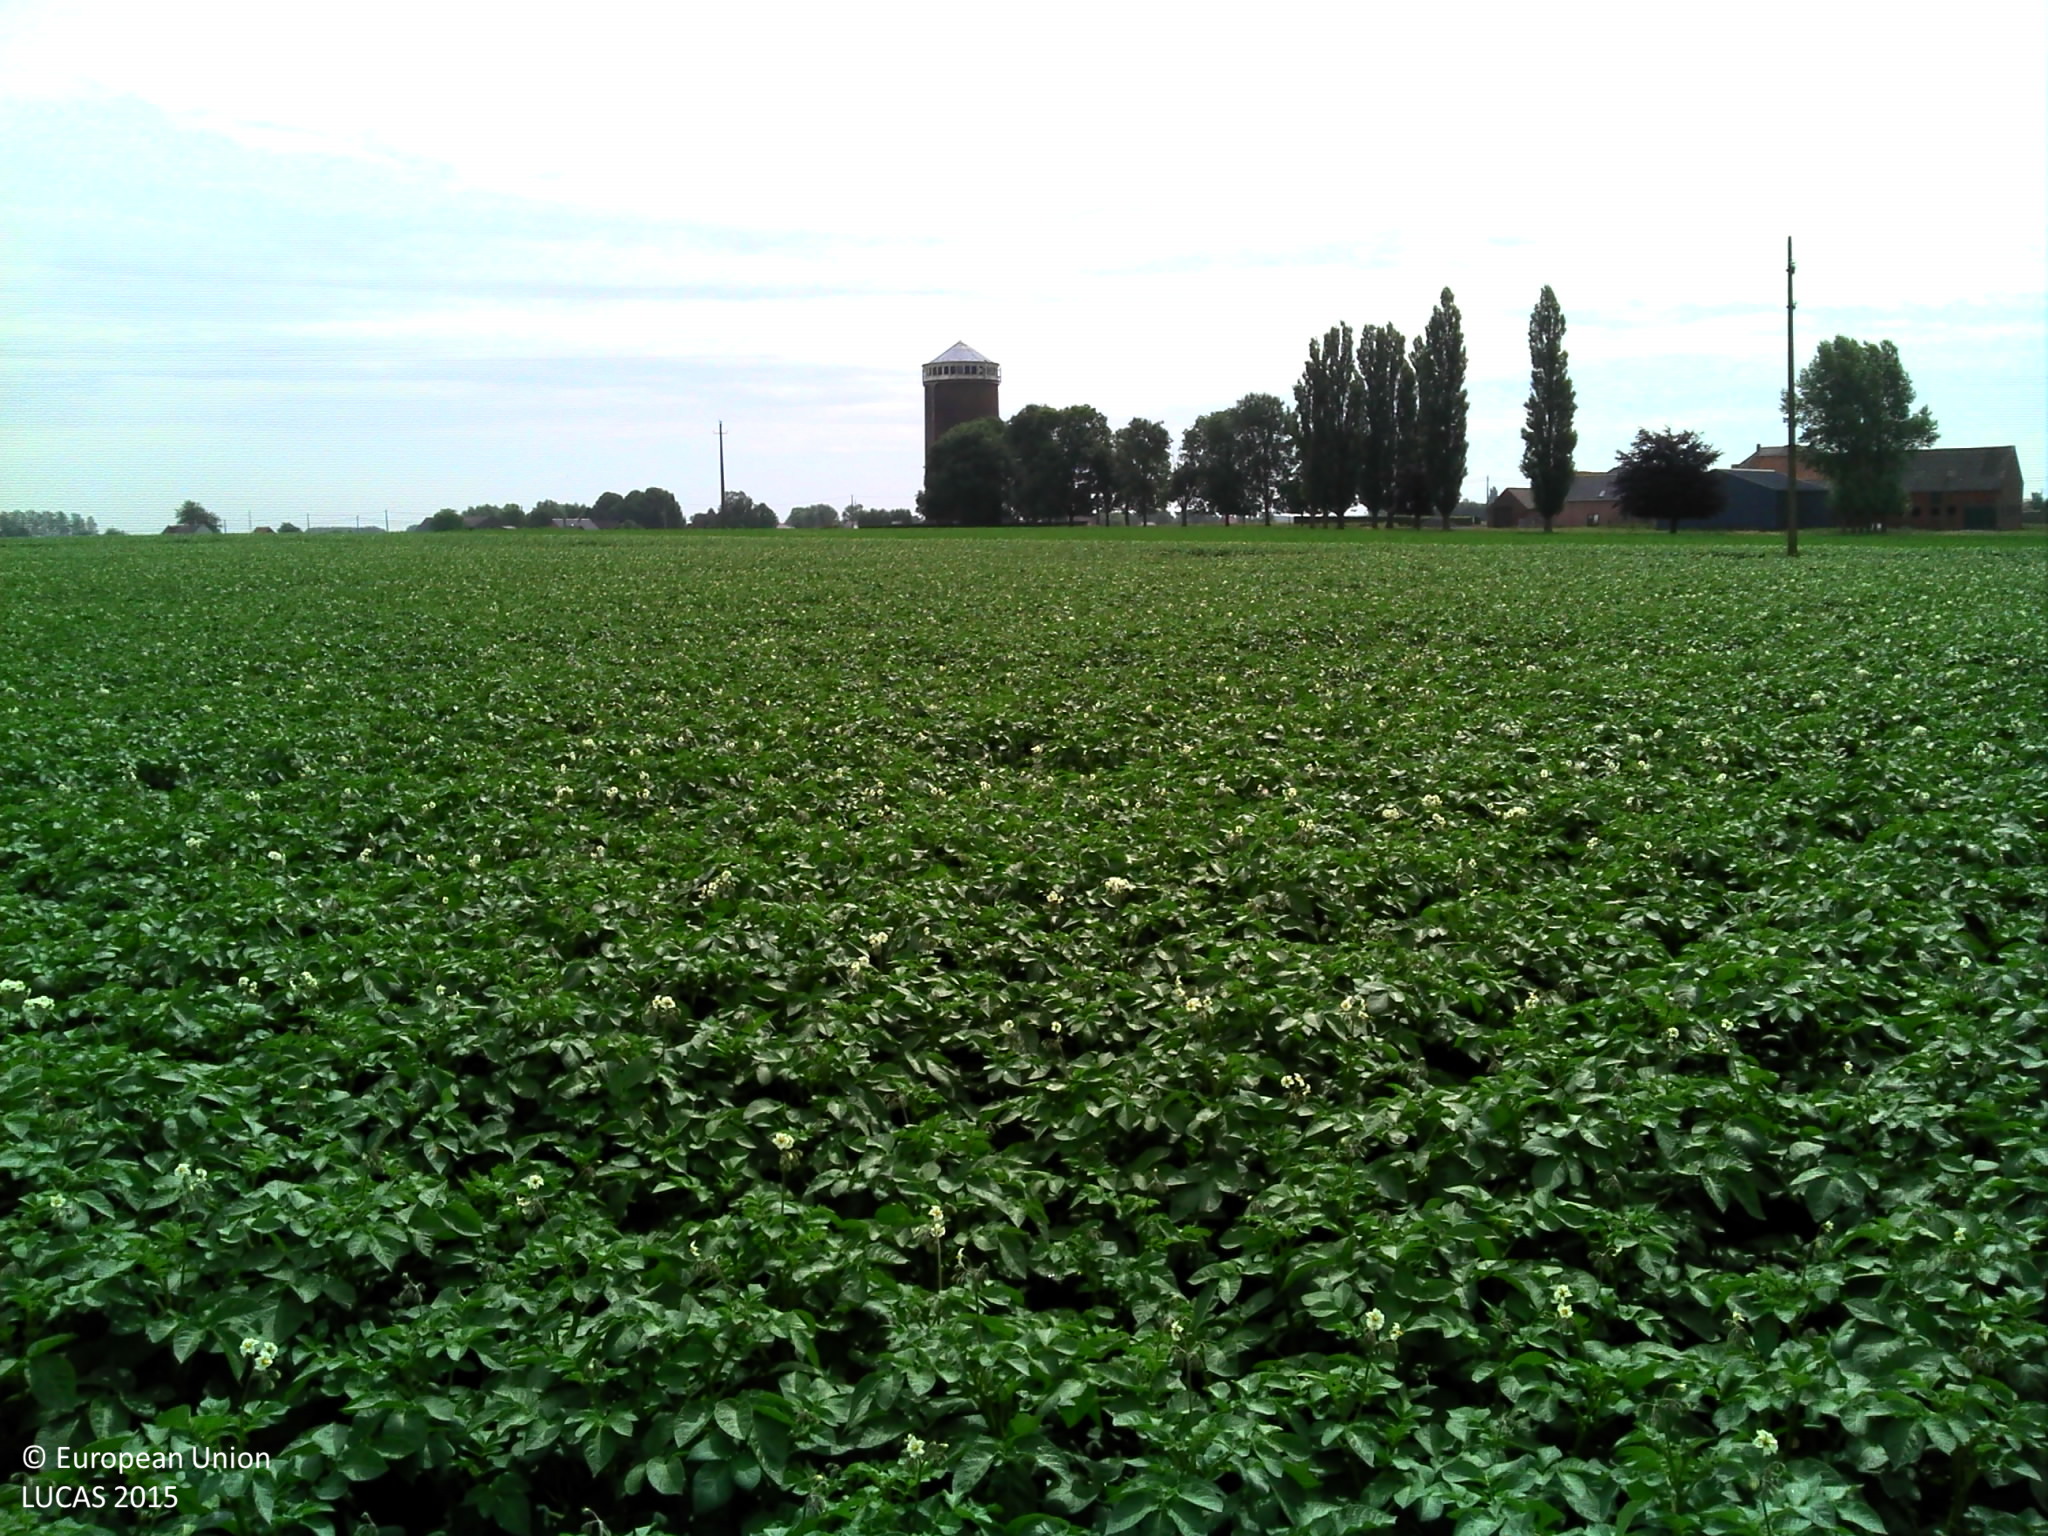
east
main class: Cropland
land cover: Potatoes
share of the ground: > 75 %
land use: Agriculture (excluding fallow land and kitchen gardens)
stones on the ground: < 10 %
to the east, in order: Potatoes; Electric lines; Potatoes; Sugar beet; Electric lines; Sugar beet
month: June
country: BE
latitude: 50.5400
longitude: 3.8274
